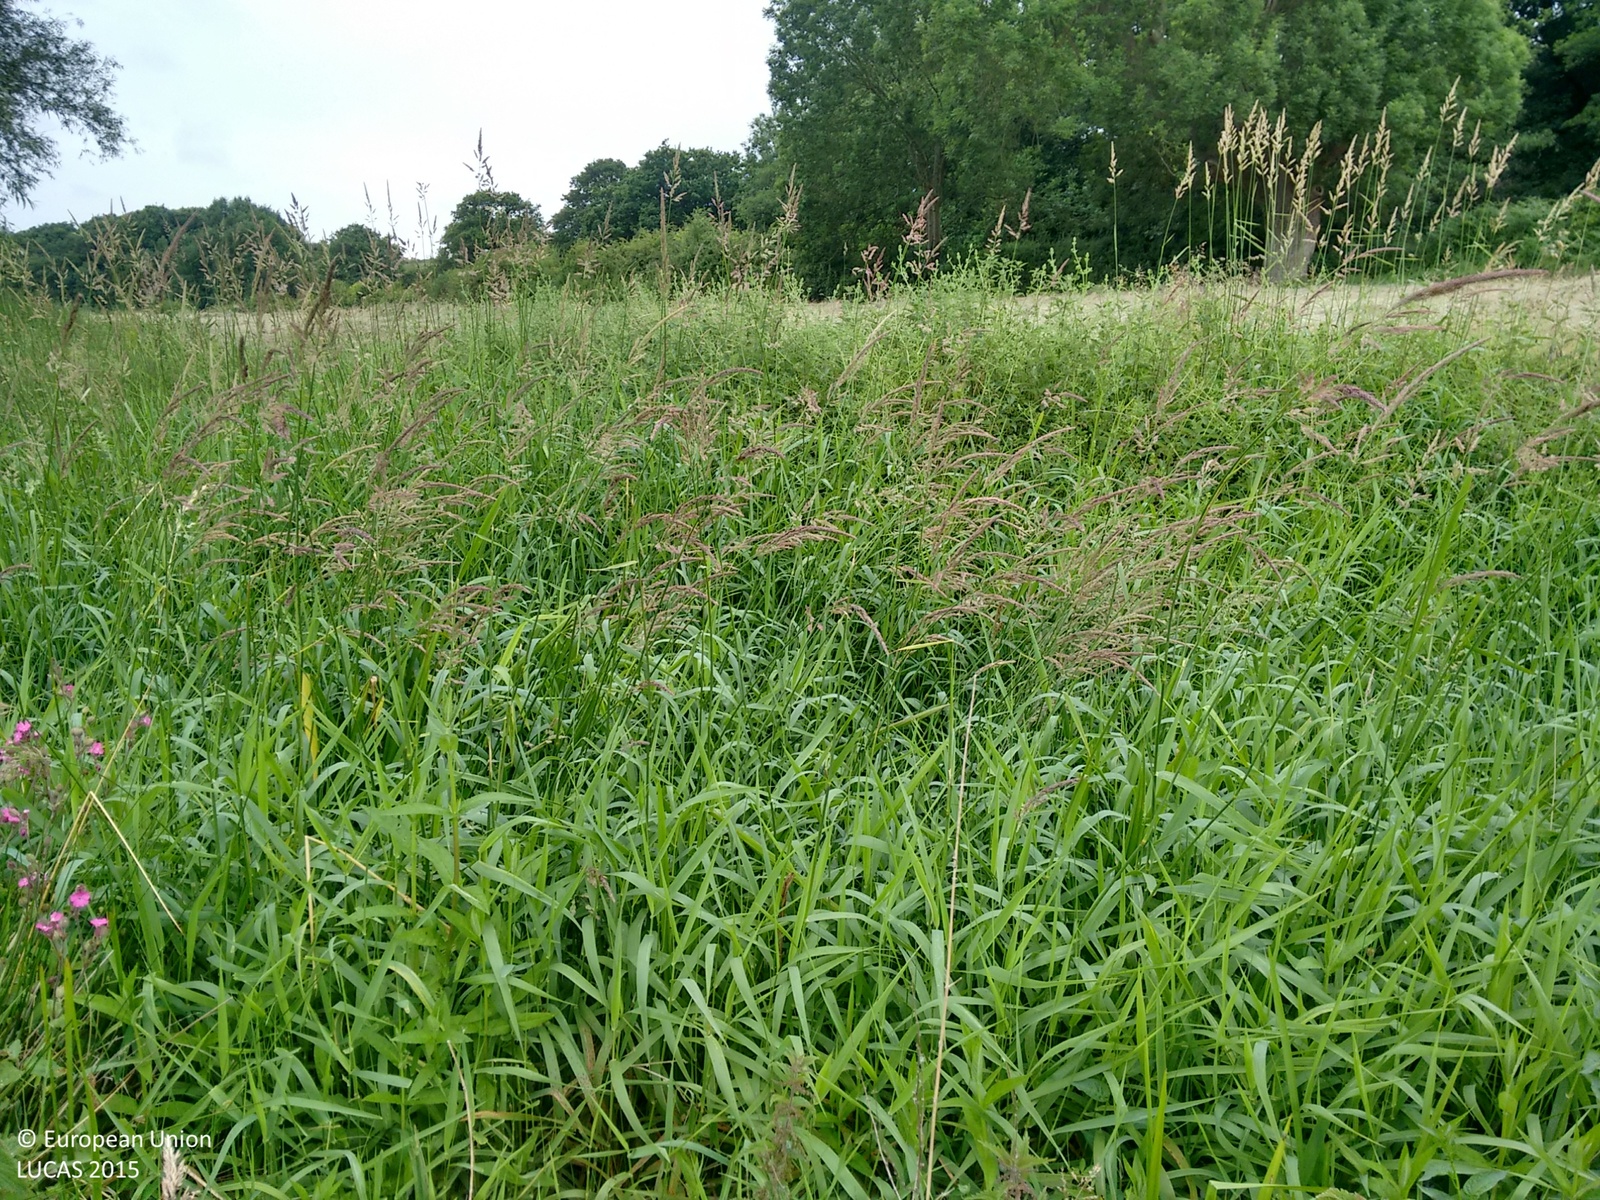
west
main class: Grassland
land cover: Grassland with sparse tree/shrub cover
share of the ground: > 75 %
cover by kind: herbaceous plants 90 %, broadleaved forest trees 5 %, shrubs 5 %
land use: Agriculture (excluding fallow land and kitchen gardens)
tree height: > 5 m
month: July
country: GB
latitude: 52.3571
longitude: -2.2642
